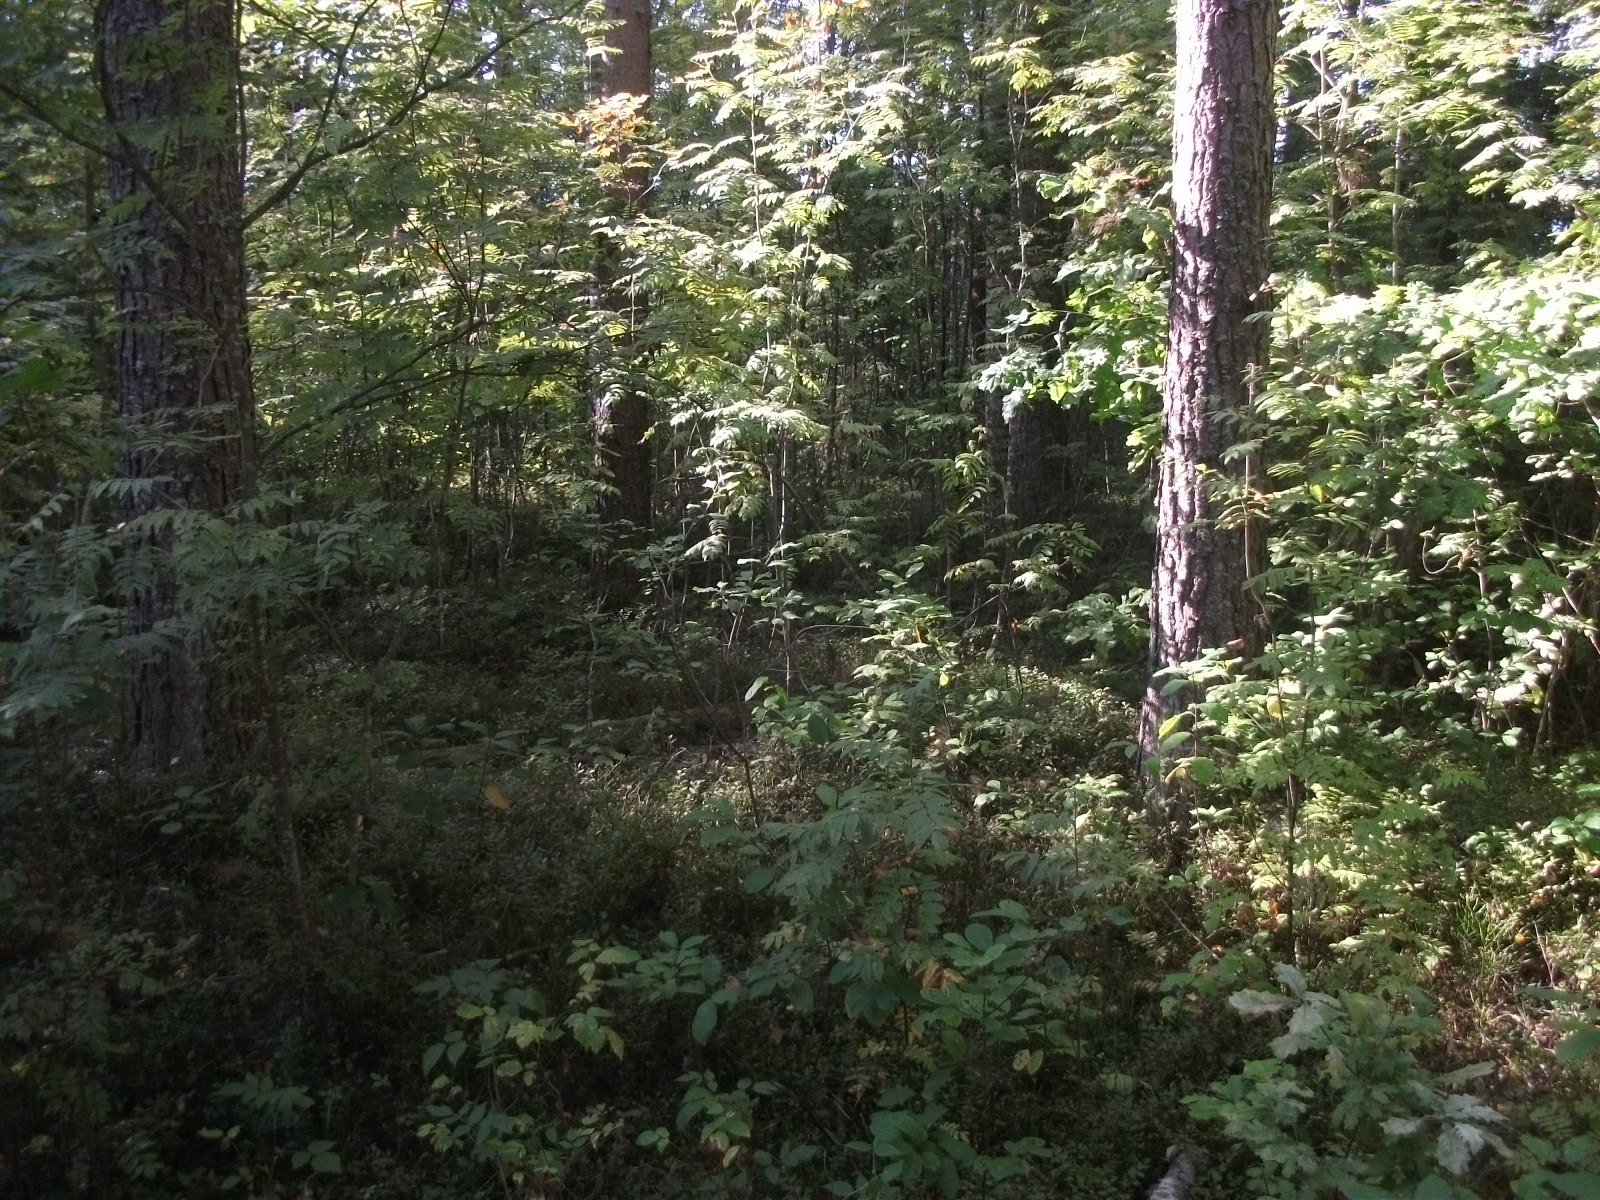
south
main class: Woodland
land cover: Pine dominated mixed woodland
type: hemiboreal forest and nemoral coniferous forest and mixed broadleaved-coniferous forest
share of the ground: > 75 %
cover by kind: coniferous forest trees 55 %, broadleaved forest trees 30 %, shrubs 10 %, herbaceous plants 5 %
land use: Forestry
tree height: > 5 m
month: August
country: LV
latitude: 56.4070
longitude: 26.1327
